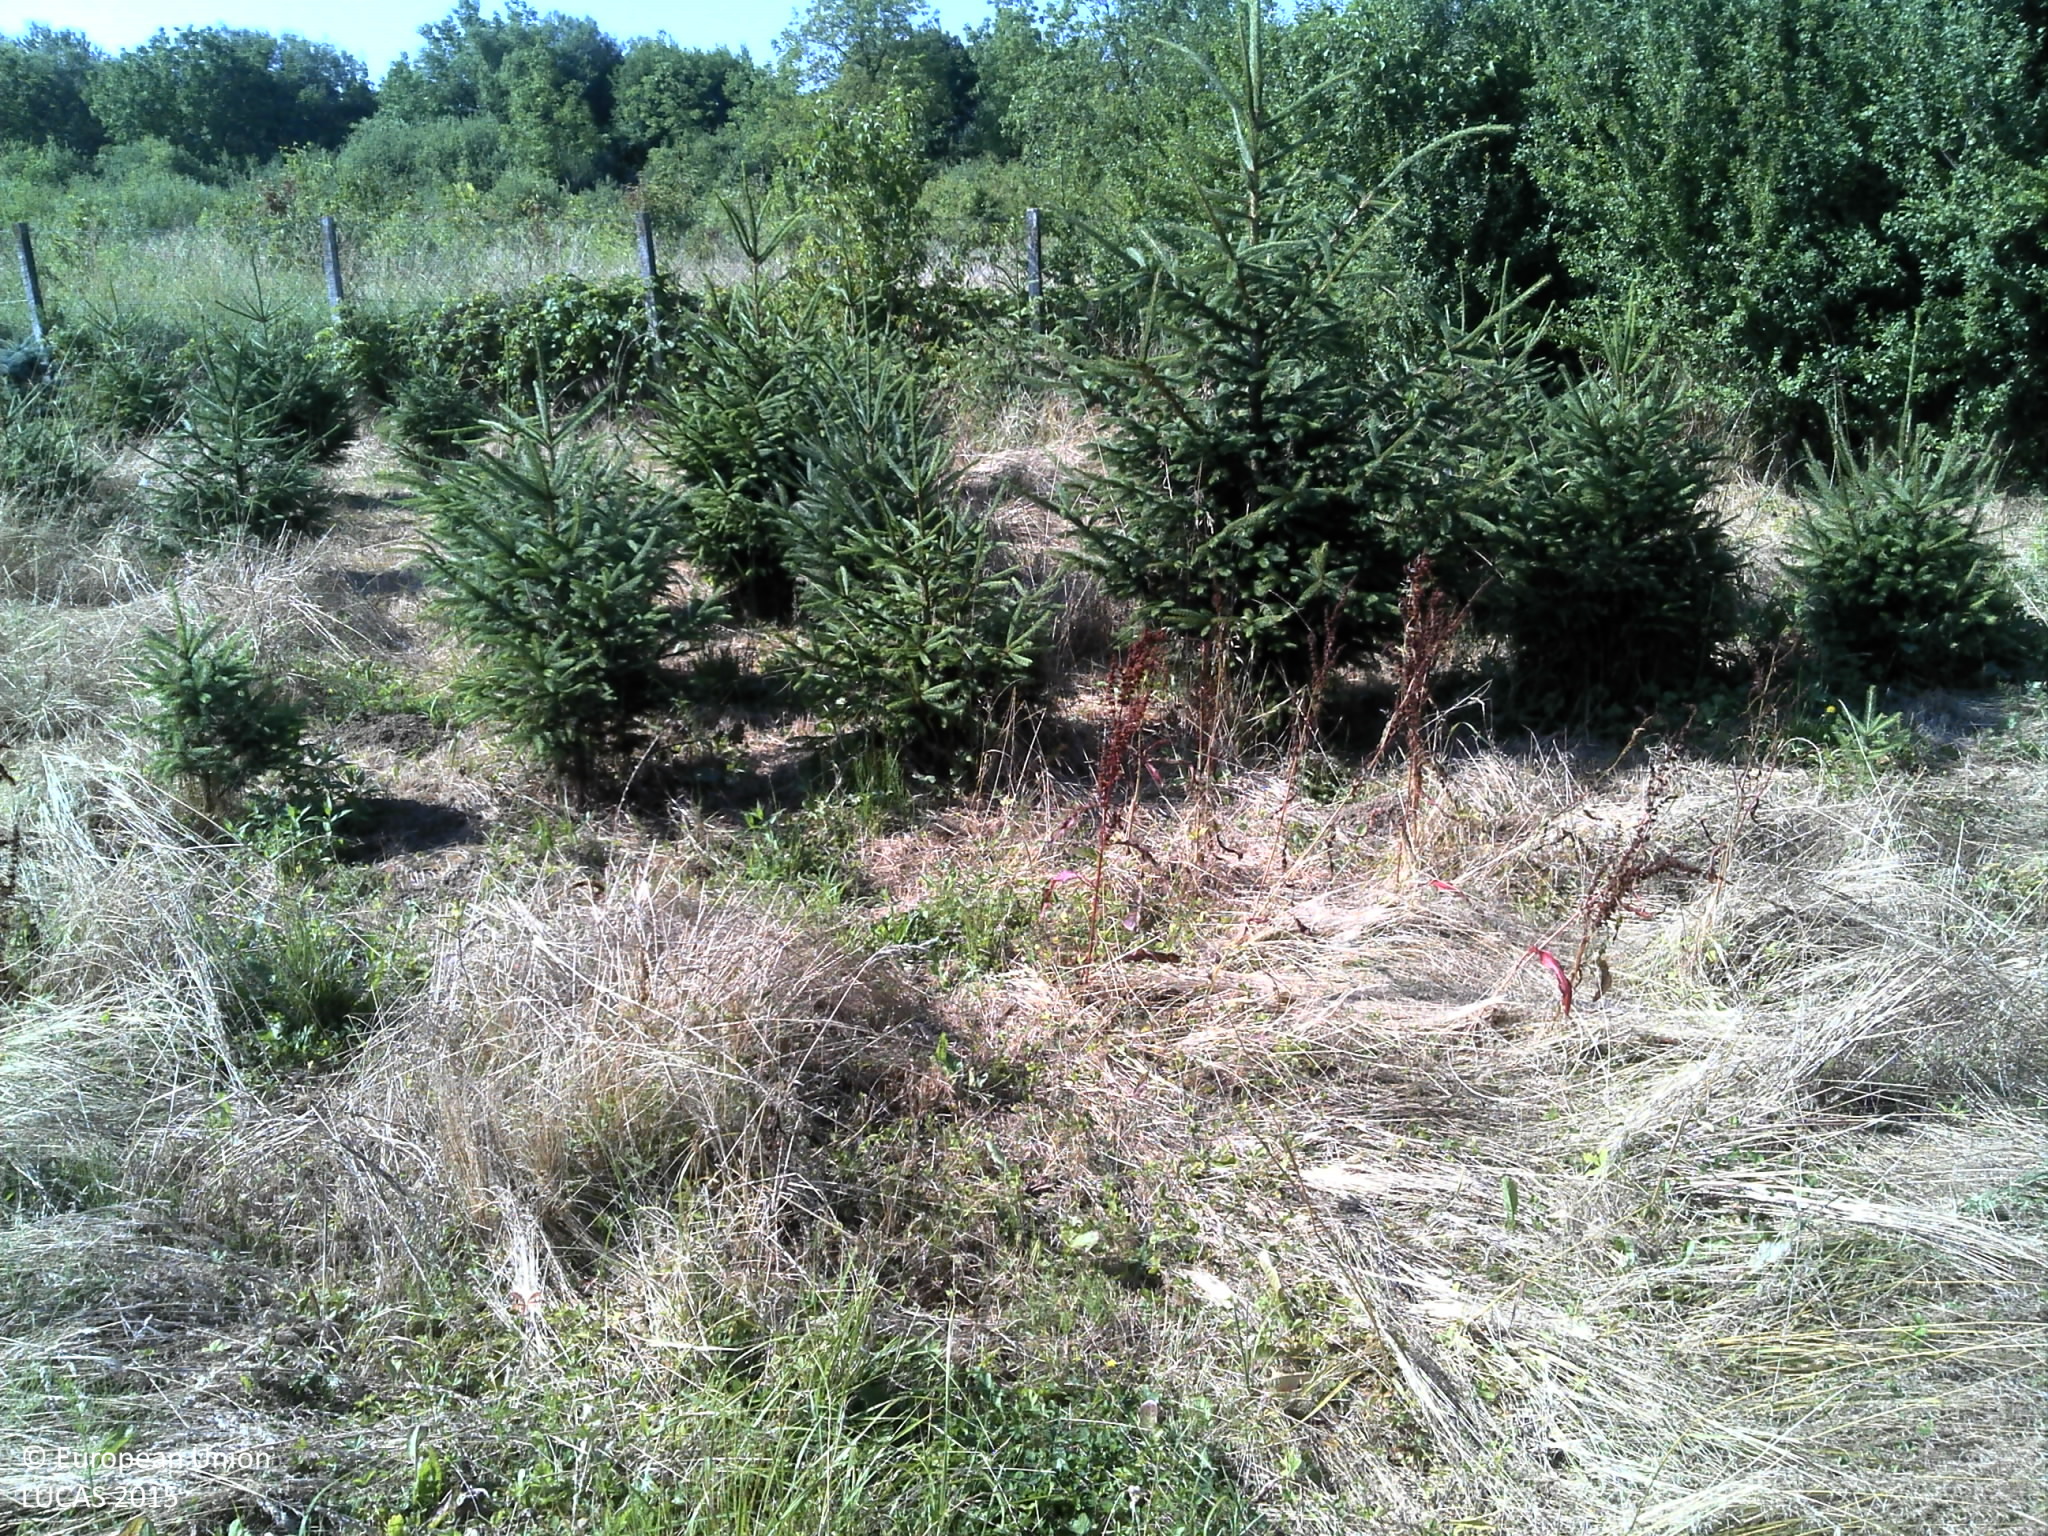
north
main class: Cropland
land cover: Nurseries
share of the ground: 10 - 25 %
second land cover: Spontaneously vegetated surfaces
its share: > 75 %
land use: Agriculture (excluding fallow land and kitchen gardens)
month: June
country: HR
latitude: 45.2462
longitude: 17.3768
